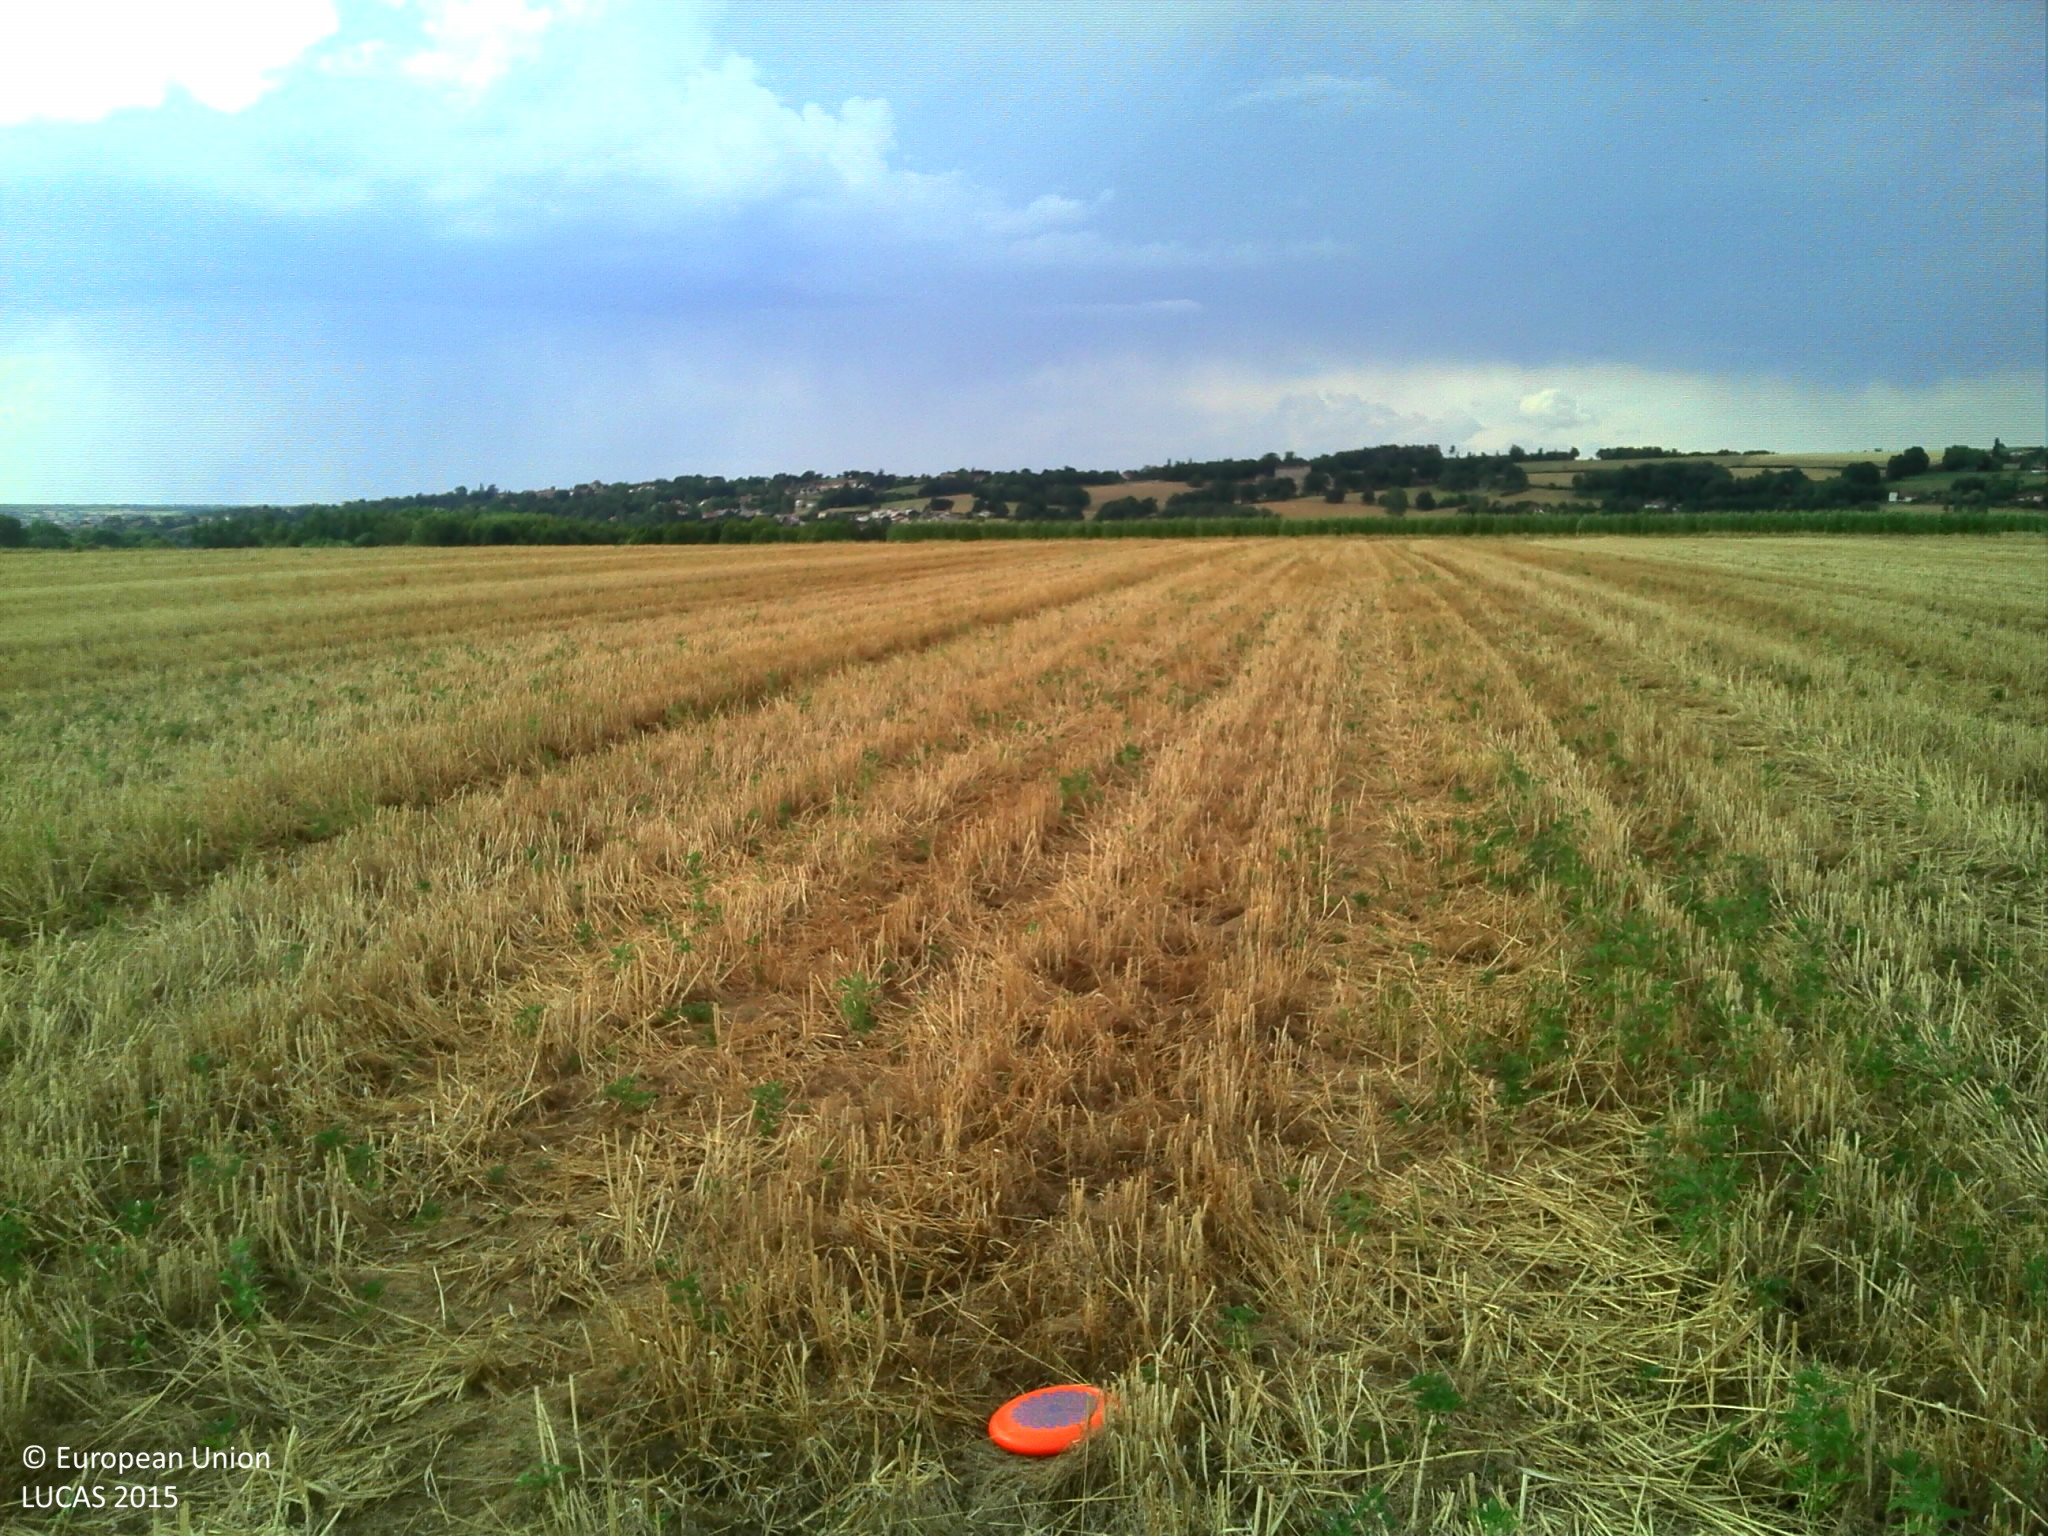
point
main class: Cropland
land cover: Common wheat
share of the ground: > 75 %
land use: Agriculture (excluding fallow land and kitchen gardens)
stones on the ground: < 10 %
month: July
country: FR
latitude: 45.3709
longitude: 5.0633
